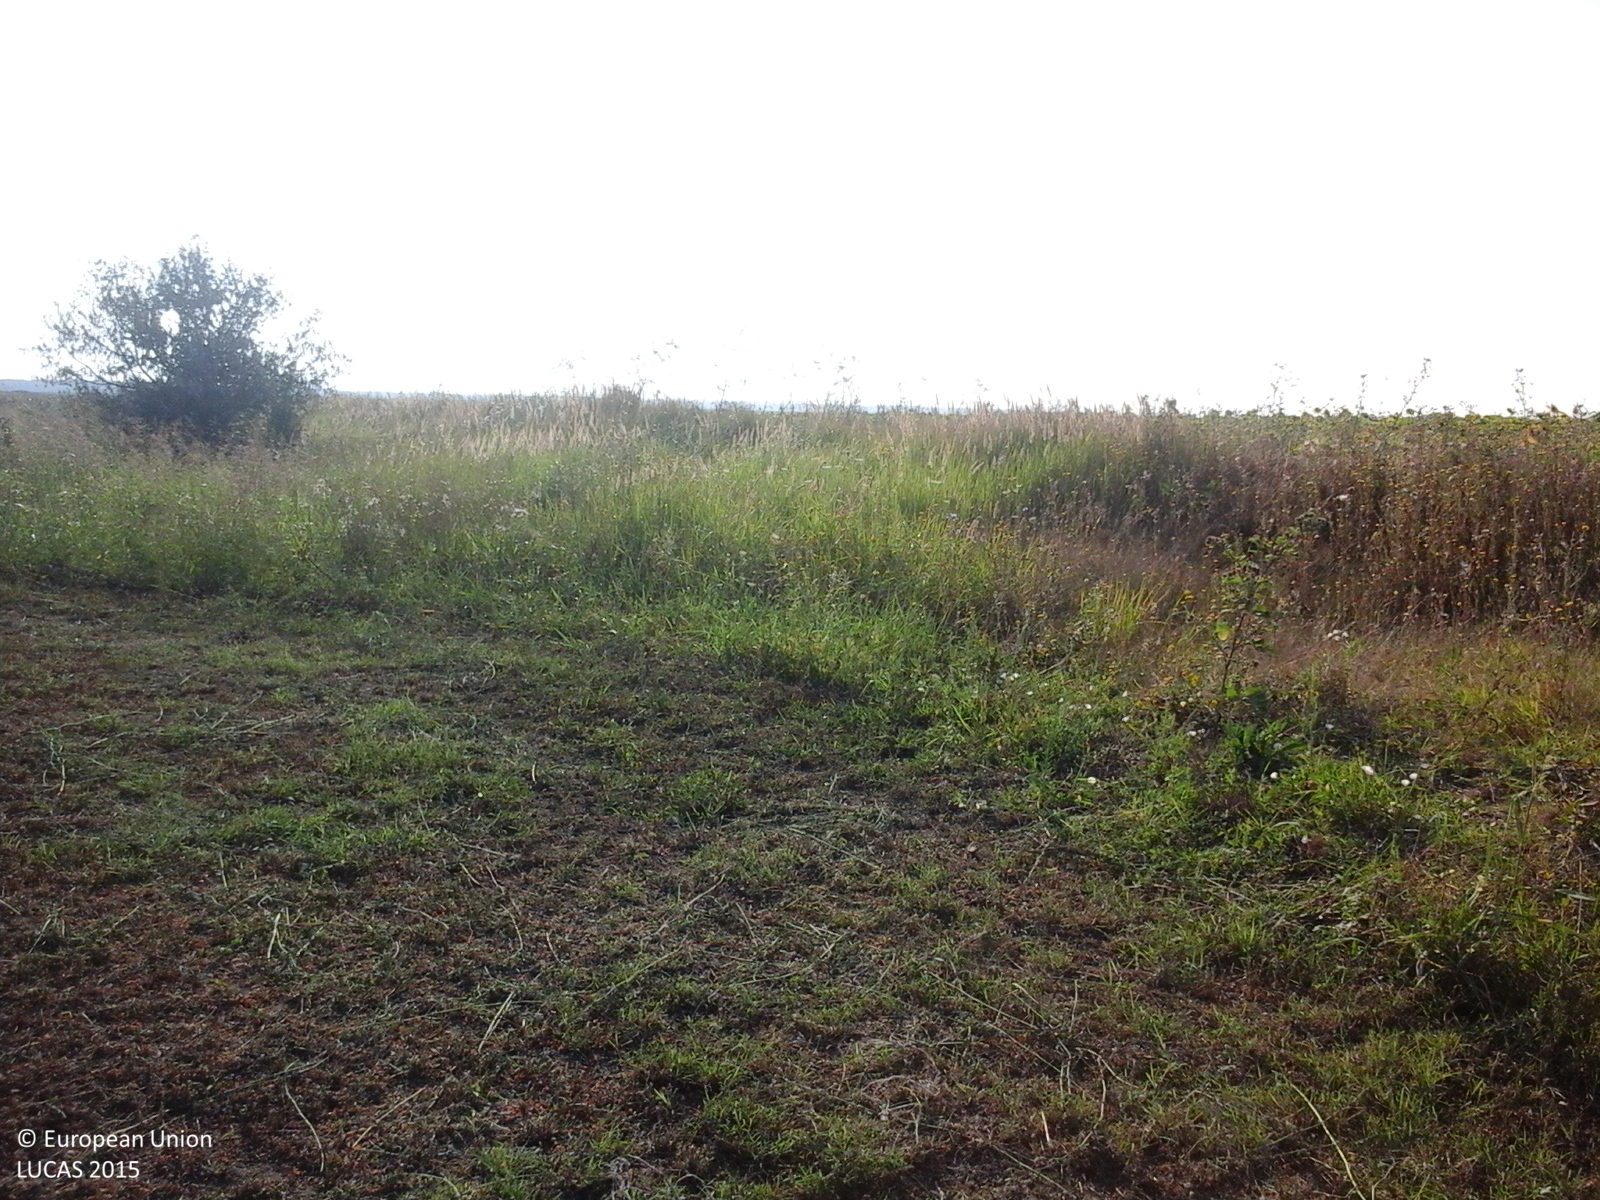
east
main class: Cropland
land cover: Lucerne
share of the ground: 50 - 75 %
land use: Agriculture (excluding fallow land and kitchen gardens)
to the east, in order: Lucerne; Spontaneously vegetated surfaces; Ditches and canals; Spontaneously vegetated surfaces; Sunflower; Grassland without tree/shrub cover; Tracks; Grassland without tree/shrub cover
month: July
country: RO
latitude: 45.5681
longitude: 27.5429
